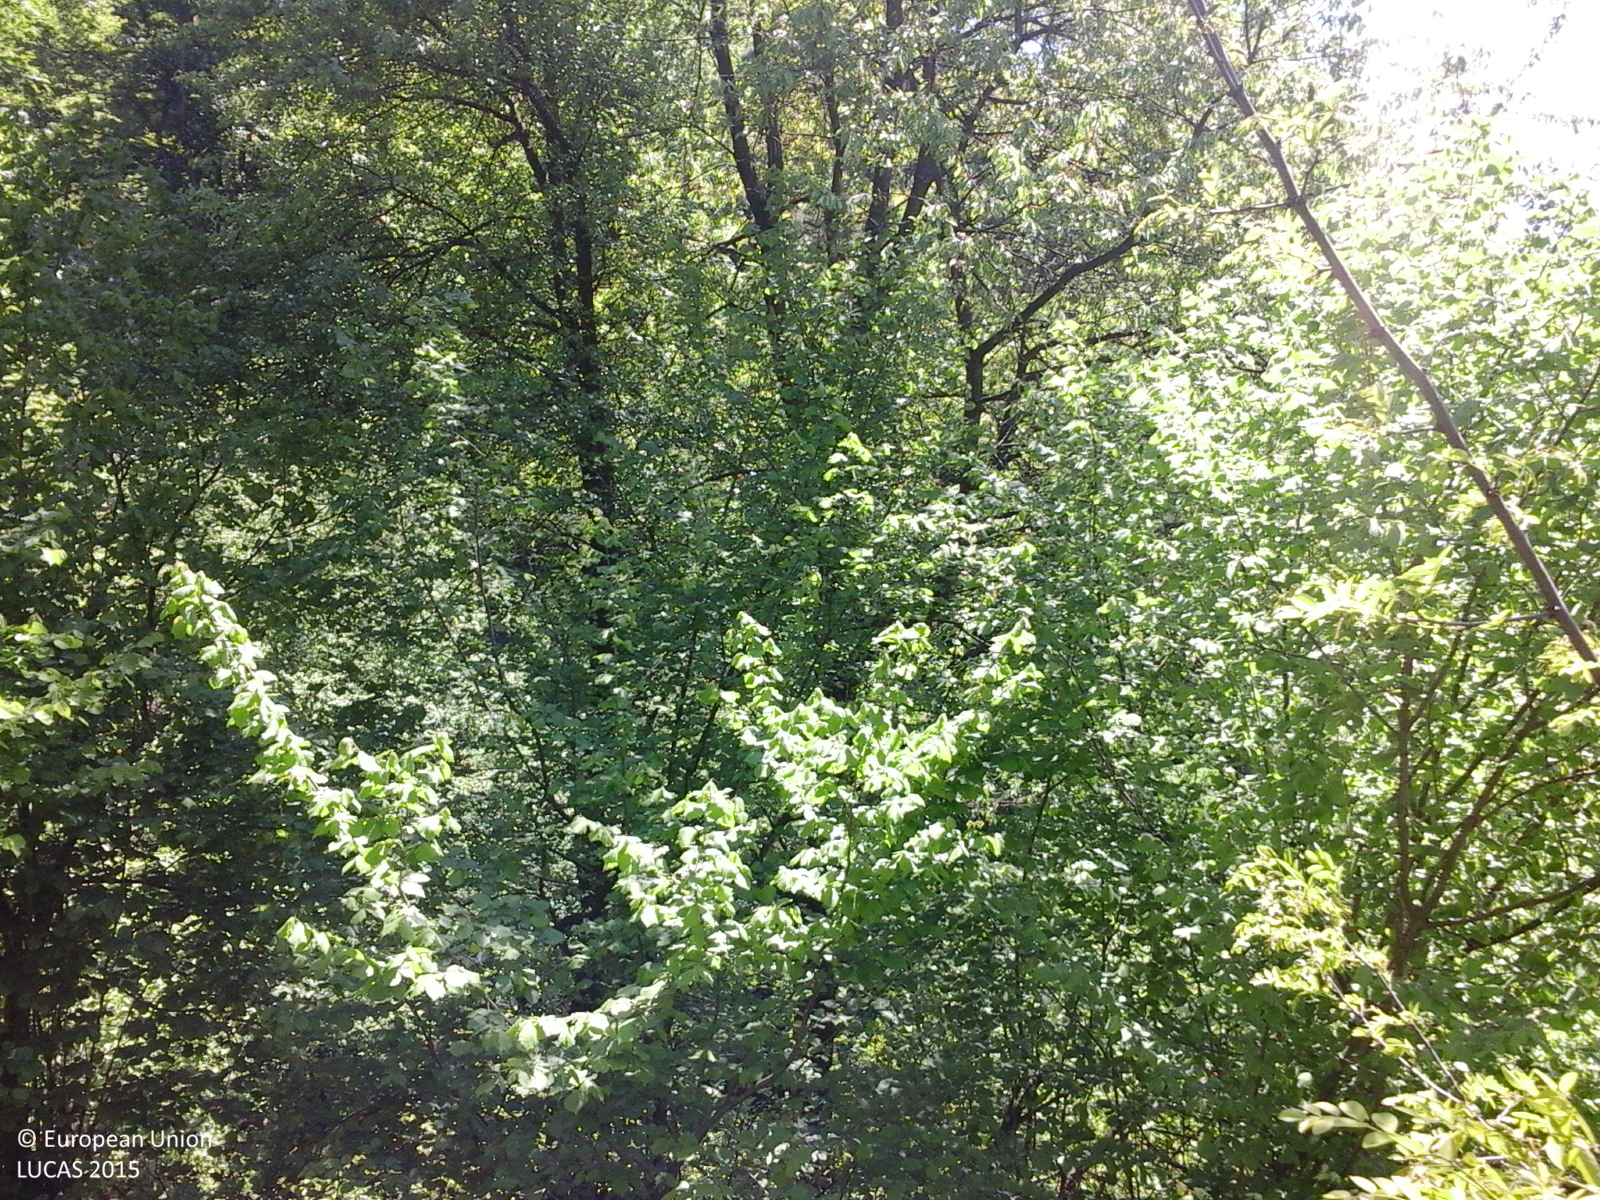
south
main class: Grassland
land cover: Grassland with sparse tree/shrub cover
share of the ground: > 75 %
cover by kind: herbaceous plants 85 %, shrubs 10 %, broadleaved forest trees 5 %
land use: Forestry
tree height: > 5 m
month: May
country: RO
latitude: 45.8112
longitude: 25.6657
